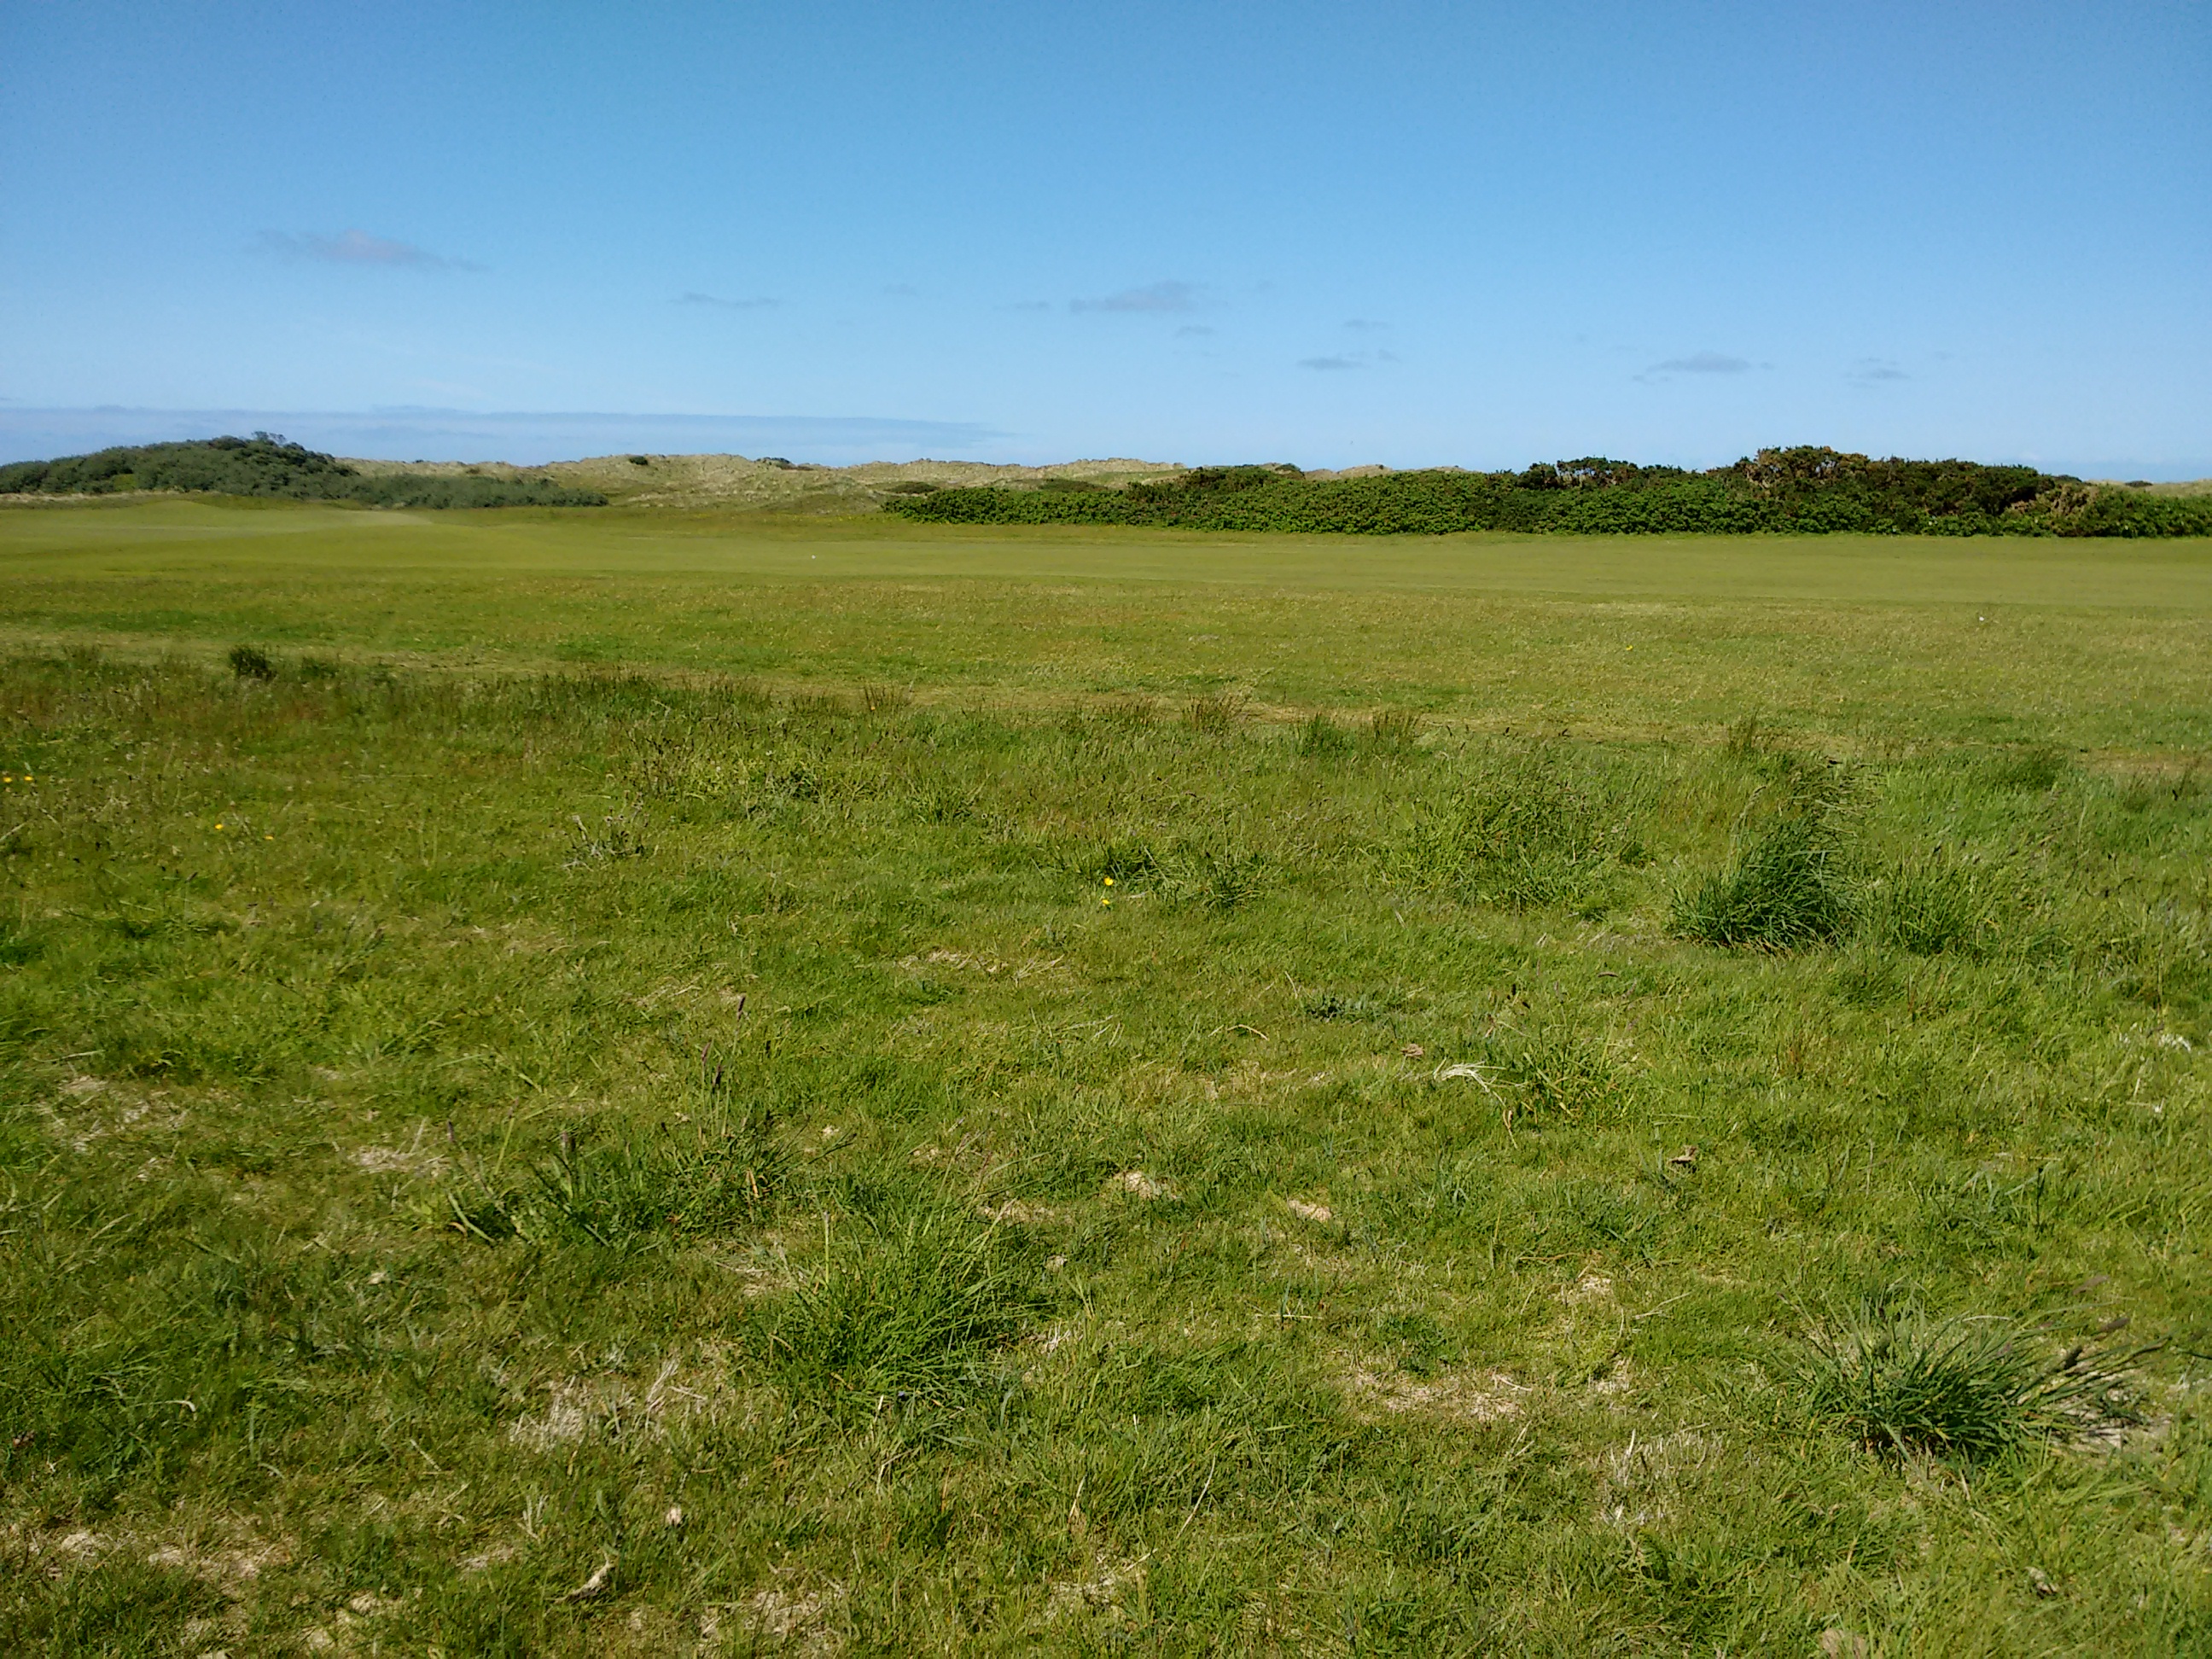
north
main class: Grassland
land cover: Grassland without tree/shrub cover
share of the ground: > 75 %
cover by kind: herbaceous plants 100 %
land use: Sport
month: June
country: GB
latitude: 55.2001
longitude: -6.6386
